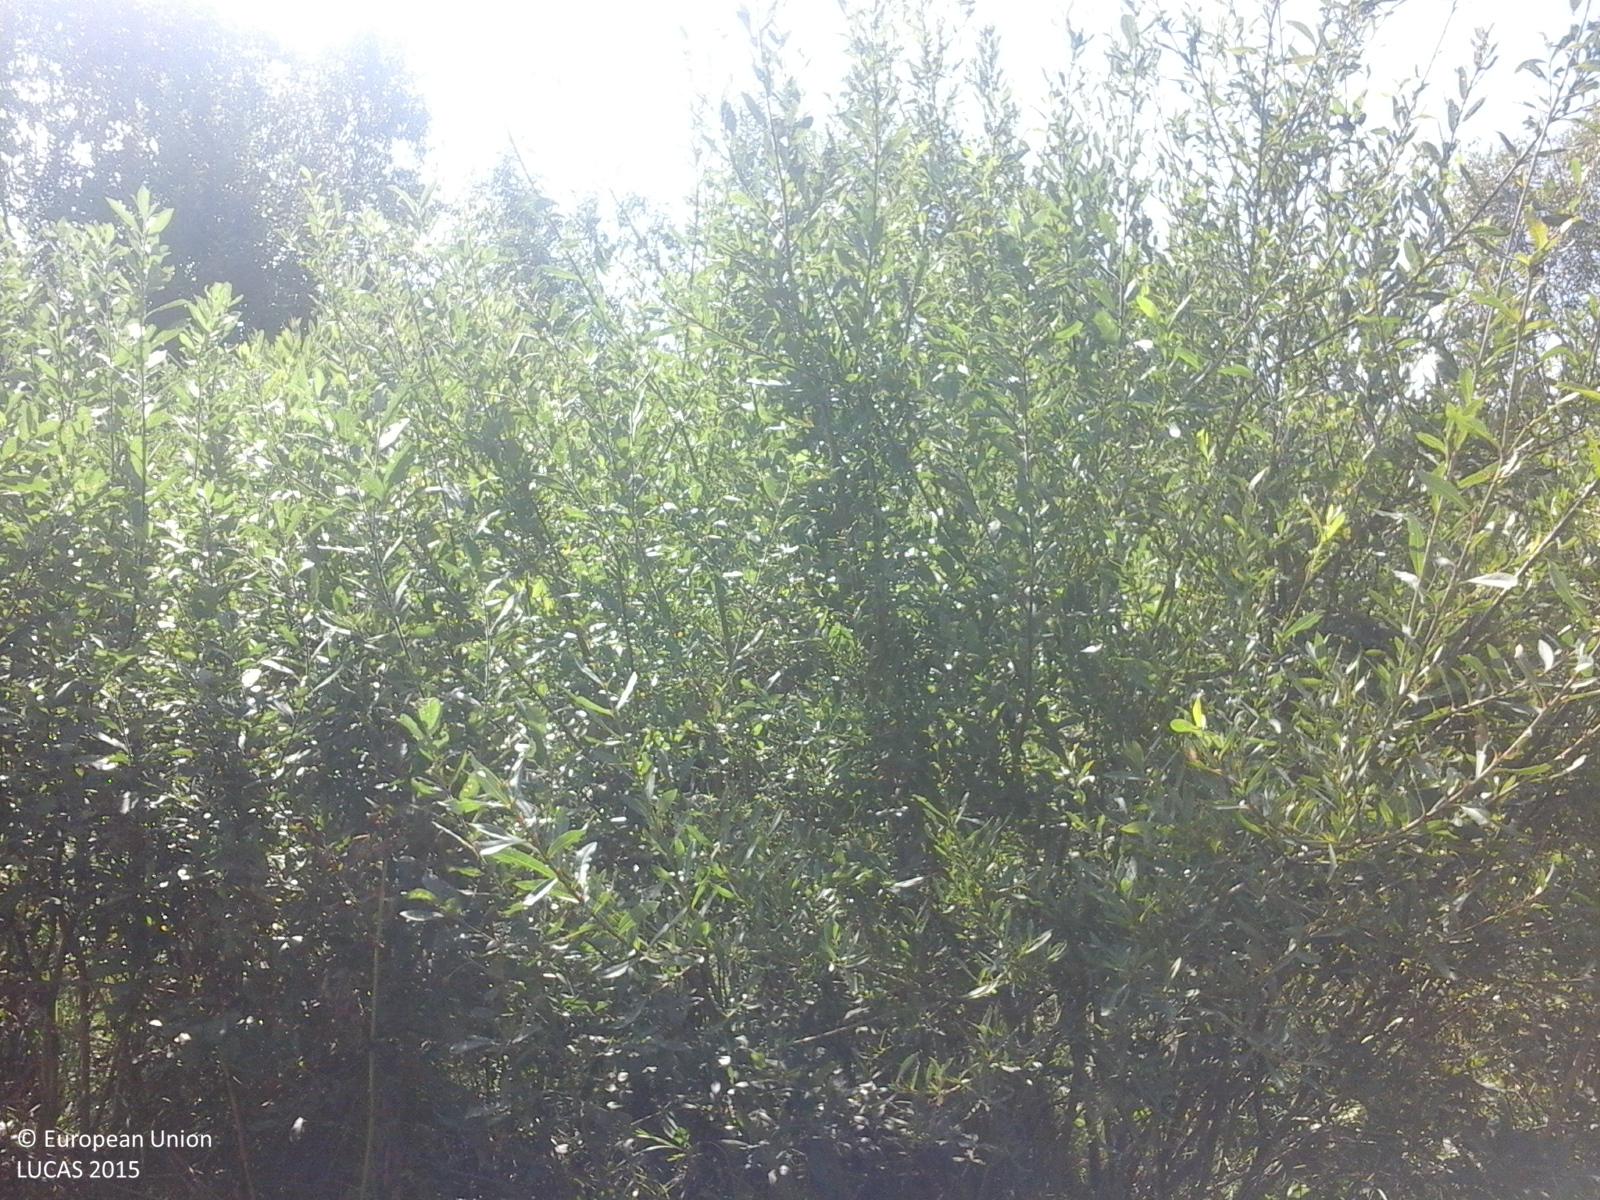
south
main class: Shrubland
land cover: Shrubland without tree cover
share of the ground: > 75 %
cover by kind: shrubs 100 %
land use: Fallow land
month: September
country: RO
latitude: 46.7644
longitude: 23.0906
